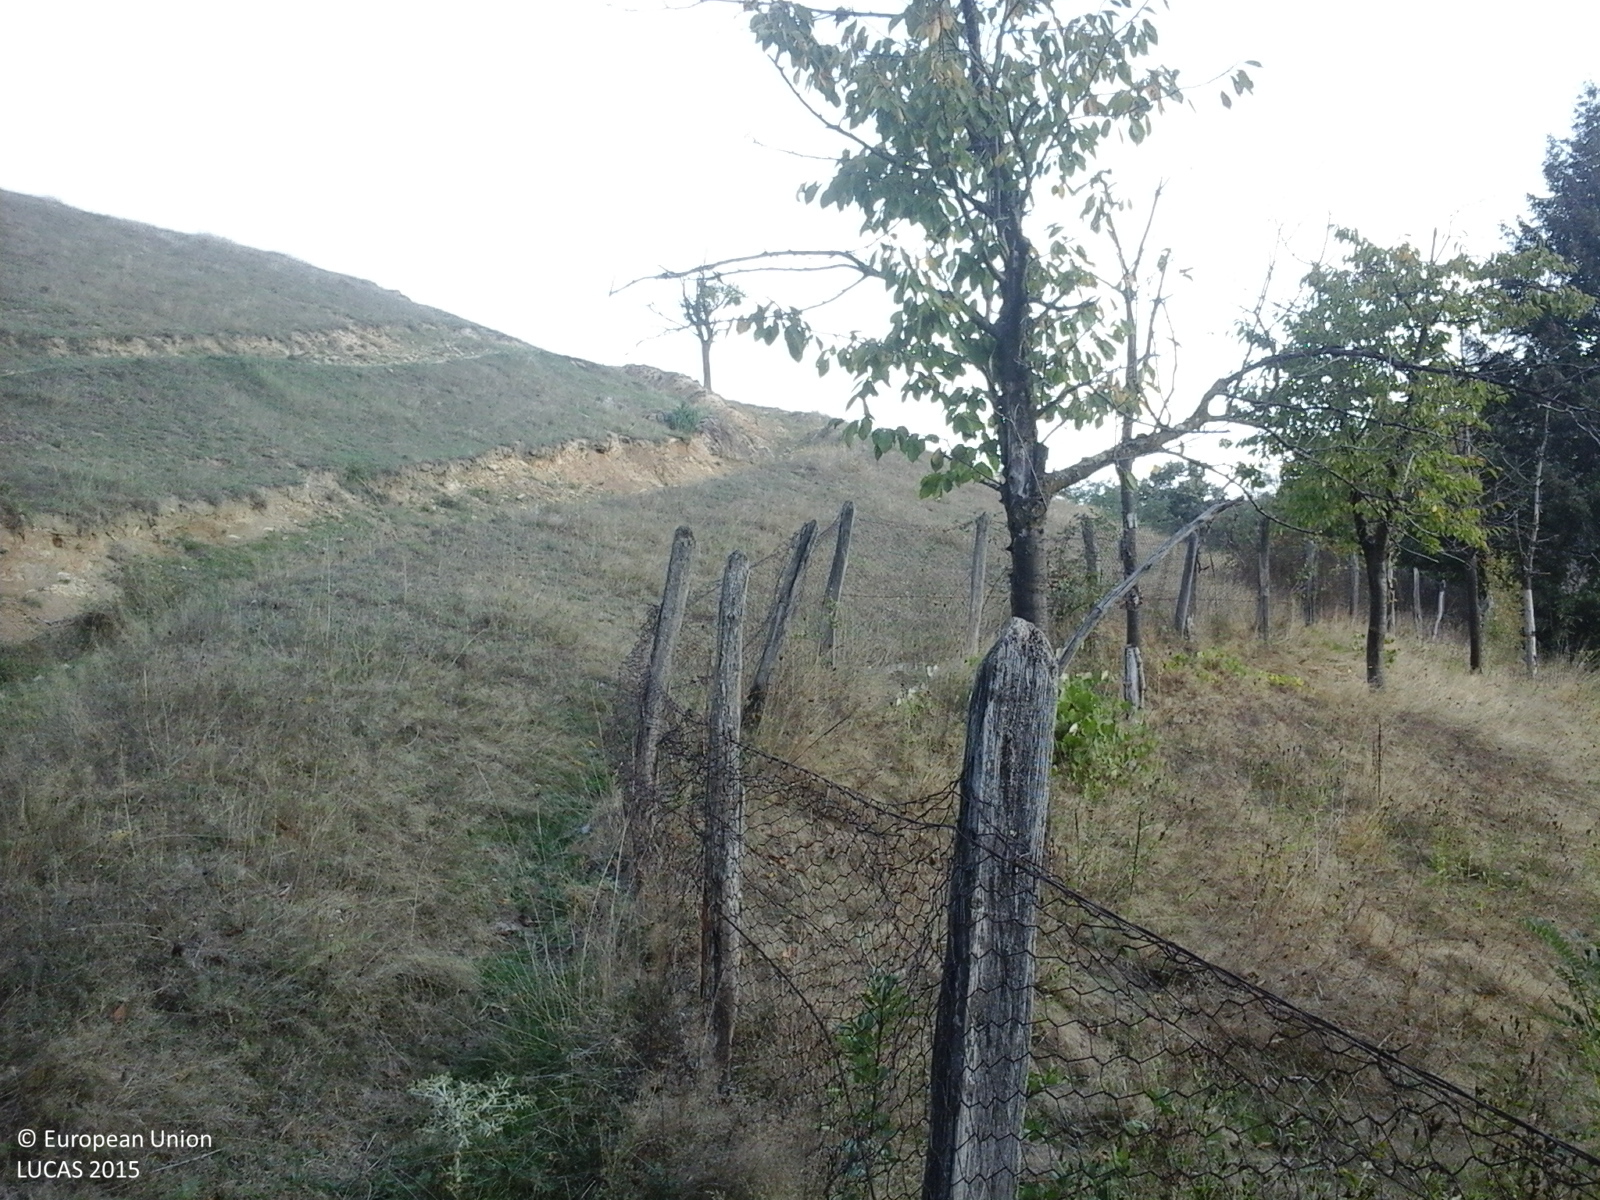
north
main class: Cropland
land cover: Other fruit trees and berries
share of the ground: 25 - 50 %
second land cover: Grassland without tree/shrub cover
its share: > 75 %
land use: Agriculture (excluding fallow land and kitchen gardens)
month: September
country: RO
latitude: 45.3457
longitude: 21.9962
